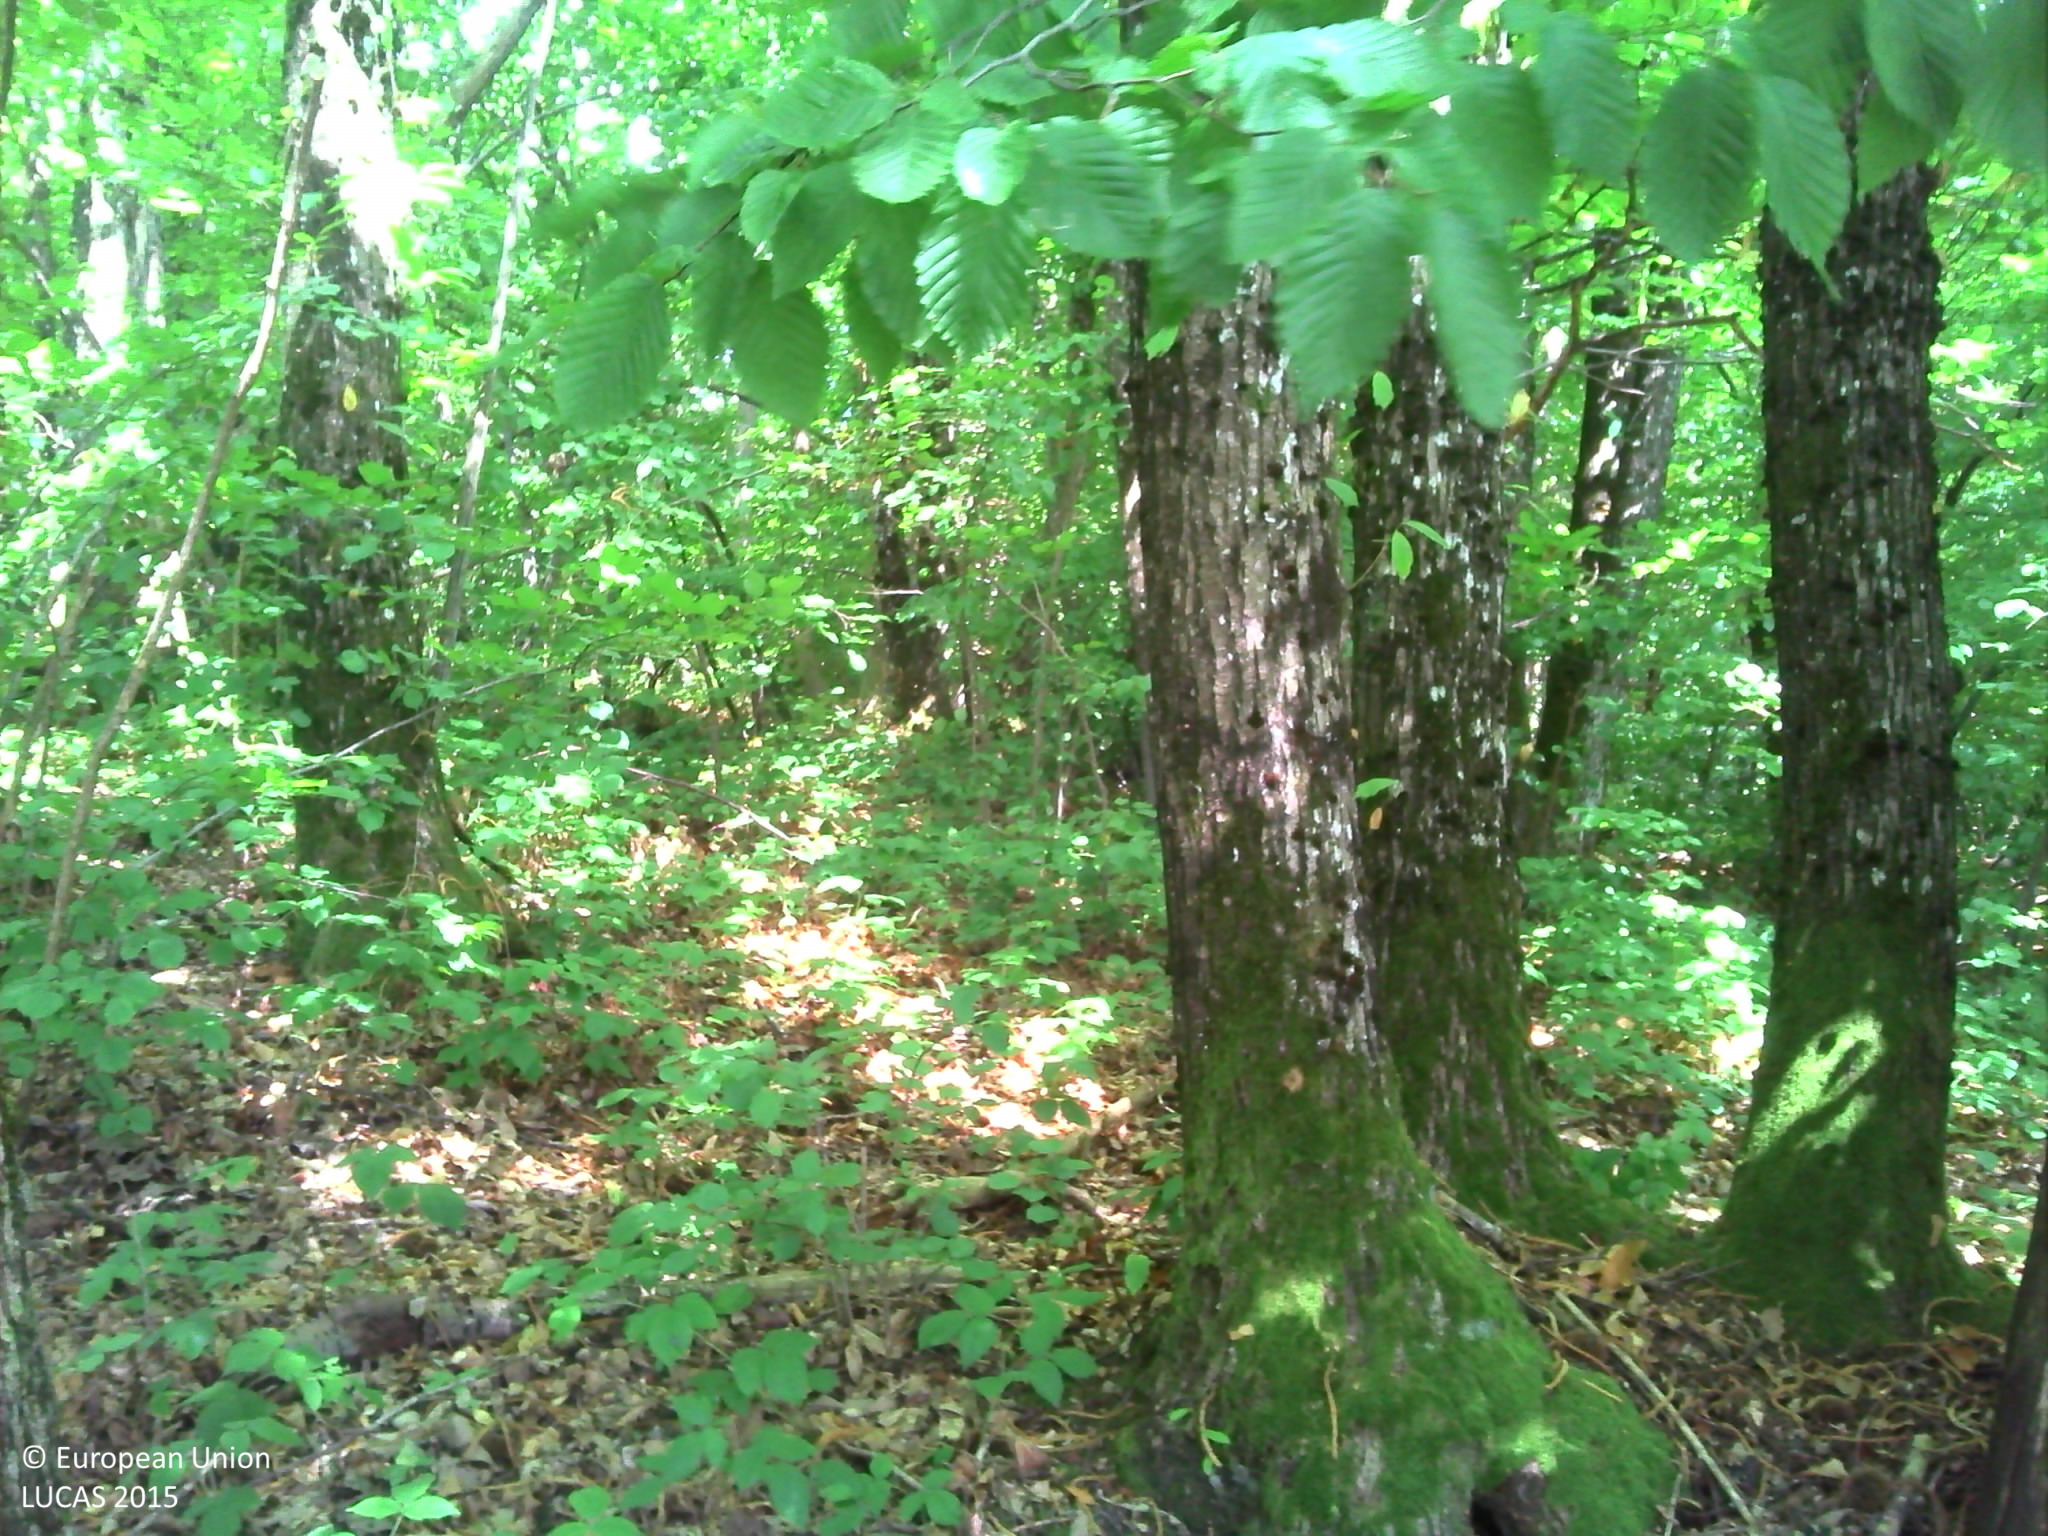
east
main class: Woodland
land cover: Broadleaved woodland
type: thermophilous deciduous forest
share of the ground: > 75 %
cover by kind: broadleaved forest trees 90 %, herbaceous plants 5 %, consolidated bare surface 5 %
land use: Forestry
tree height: > 5 m
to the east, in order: Broadleaved woodland; Tracks; Broadleaved woodland; Fences; Grassland without tree/shrub cover; Fences; Grassland without tree/shrub cover; Fences; Grass margins; Tracks; Broadleaved woodland; Tracks; Broadleaved woodland
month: July
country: FR
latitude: 45.4676
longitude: 5.6177
